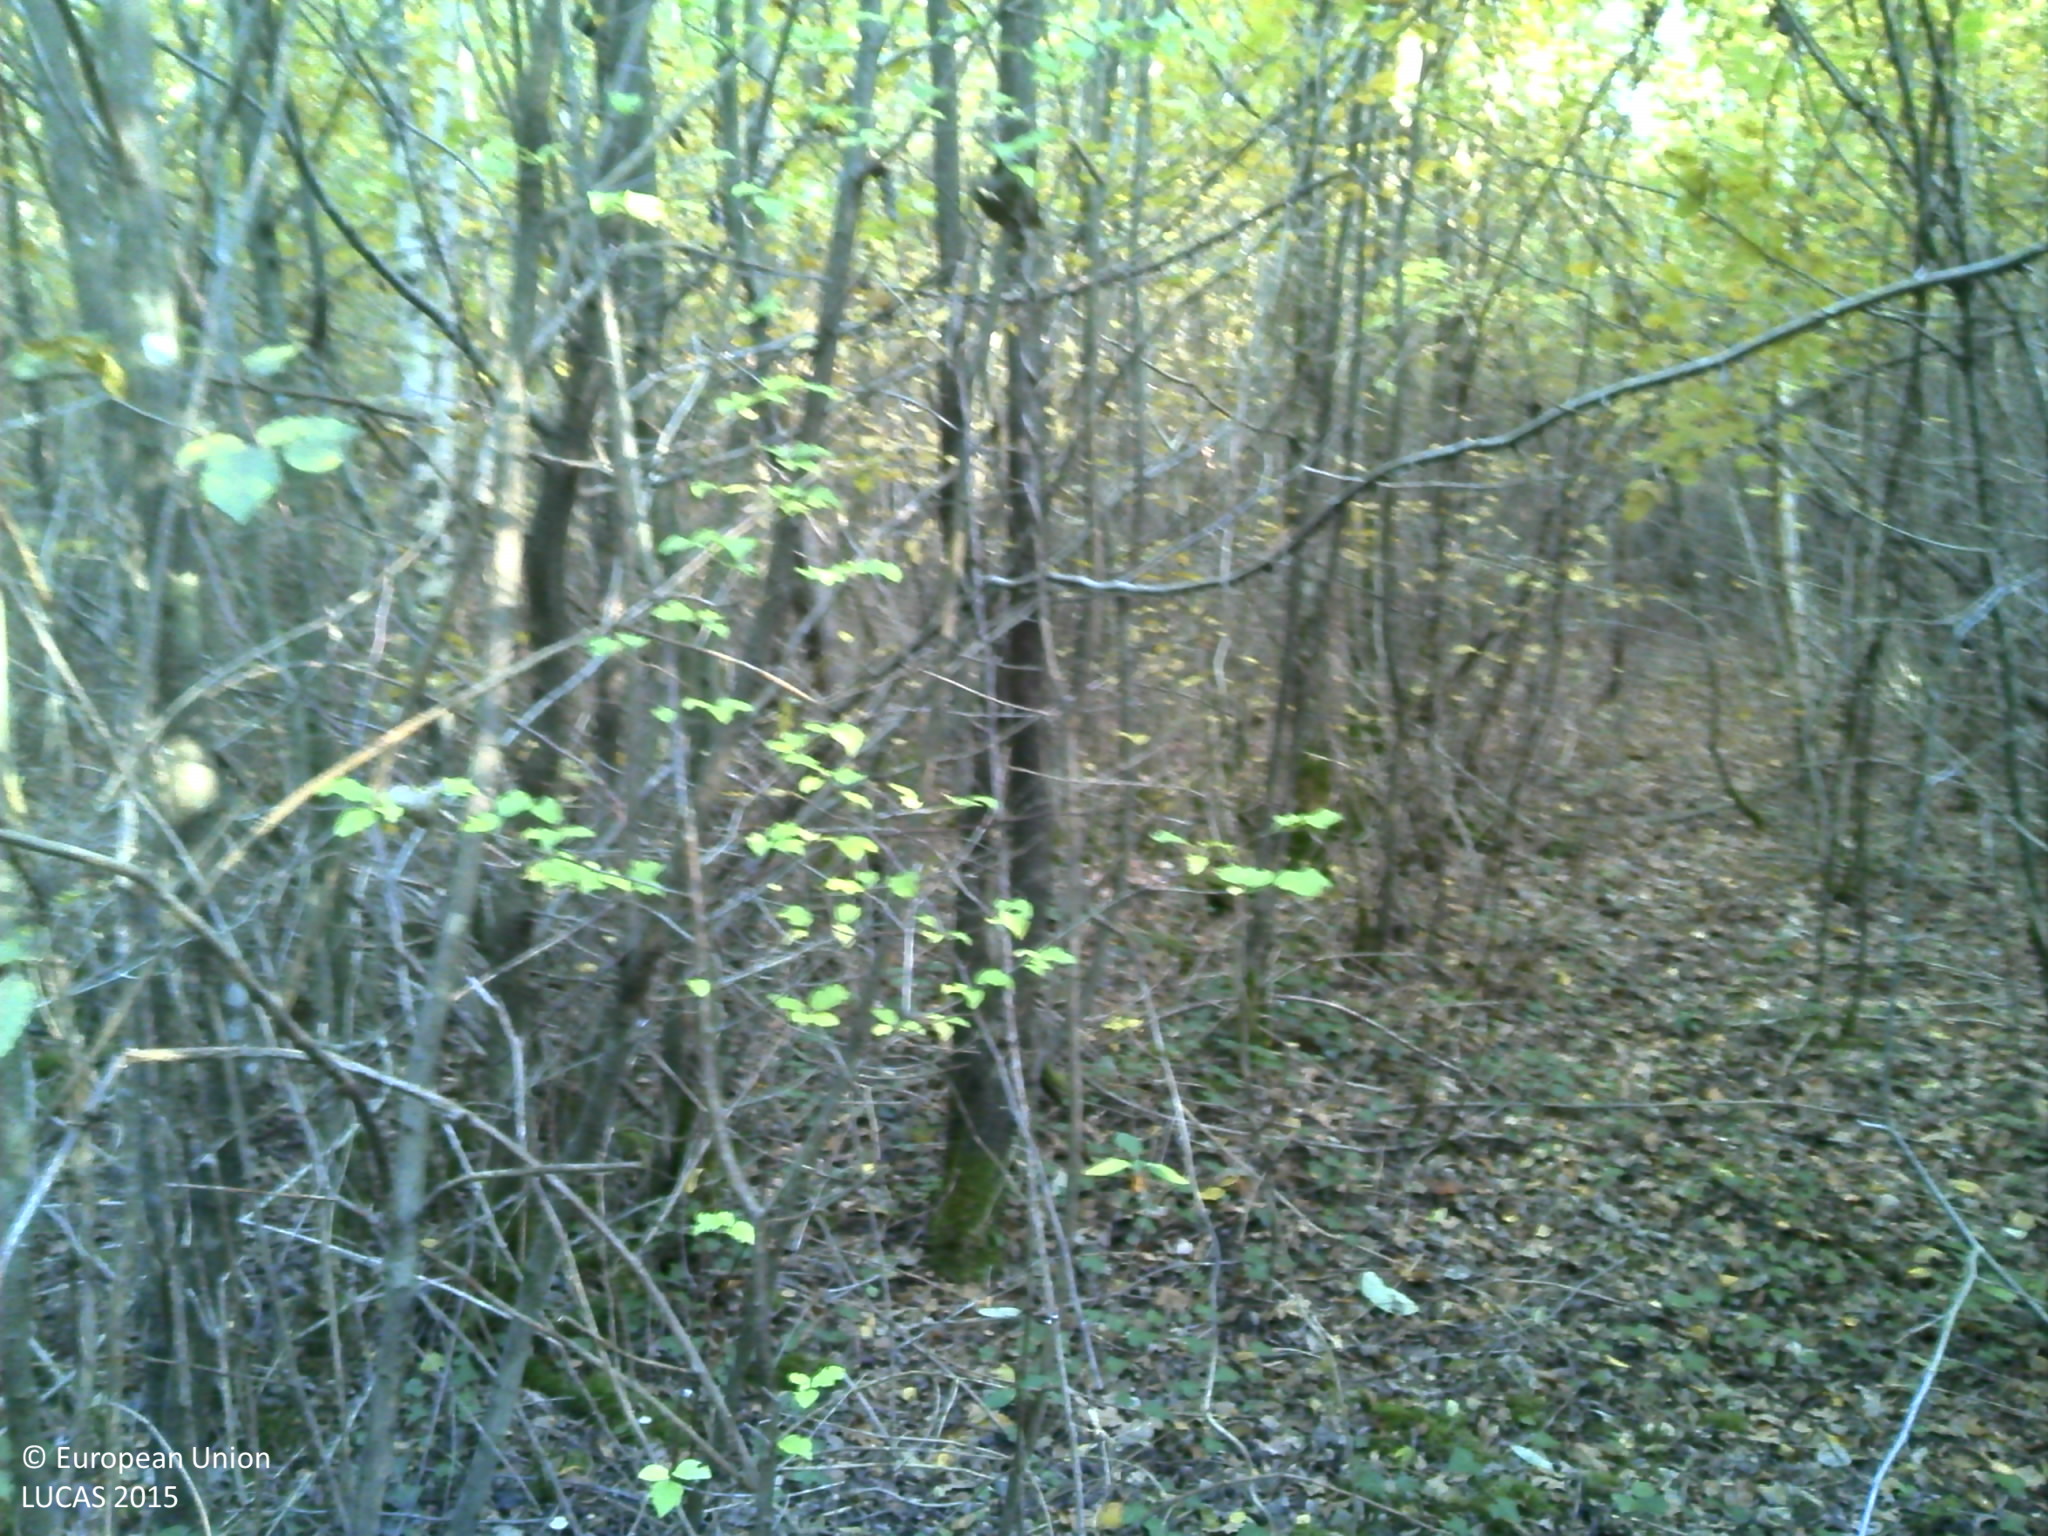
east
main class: Woodland
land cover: Broadleaved woodland
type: mesophytic deciduous forest
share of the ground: > 75 %
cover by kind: broadleaved forest trees 100 %
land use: Forestry
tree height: > 5 m
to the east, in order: Broadleaved woodland; Ditches and canals; Broadleaved woodland; Tracks; Broadleaved woodland
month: October
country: FR
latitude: 47.1877
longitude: 5.3425
